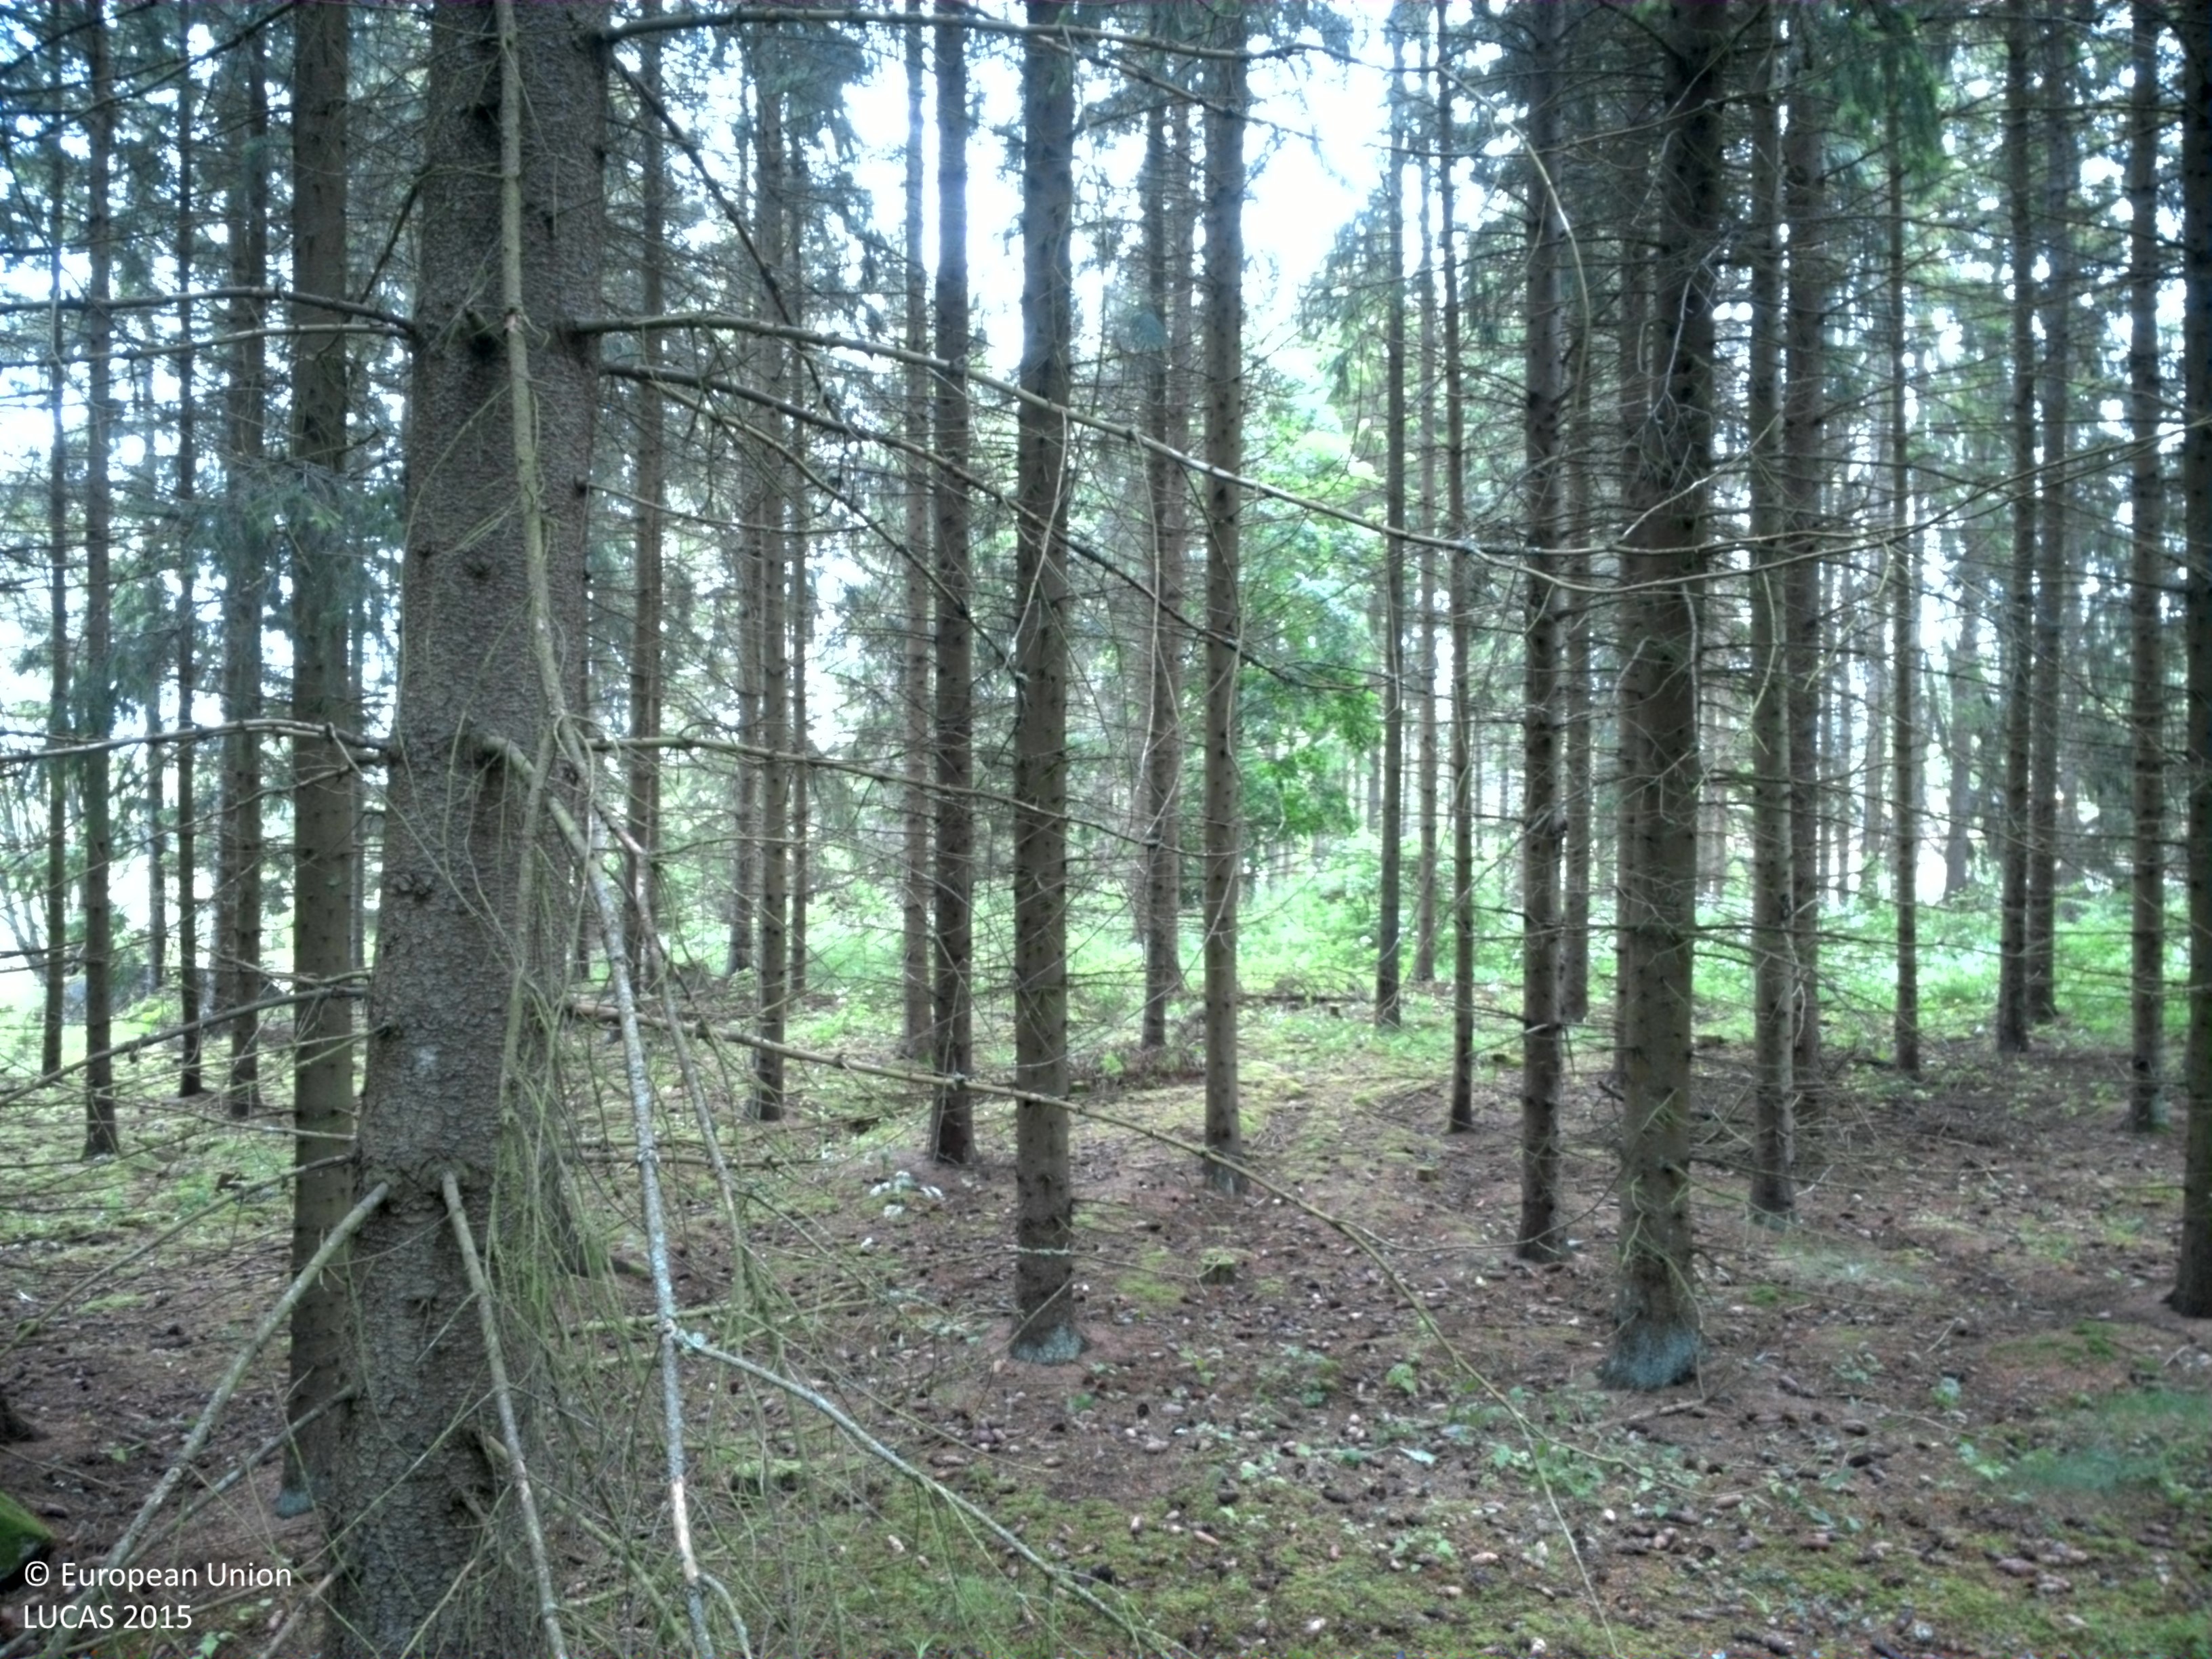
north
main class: Woodland
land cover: Spruce dominated coniferous woodland
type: boreal forest
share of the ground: > 75 %
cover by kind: coniferous forest trees 70 %, herbaceous plants 20 %, broadleaved forest trees 5 %, lichens and mosses 5 %
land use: Forestry
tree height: > 5 m
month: June
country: SE
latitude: 59.6273
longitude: 16.9970
